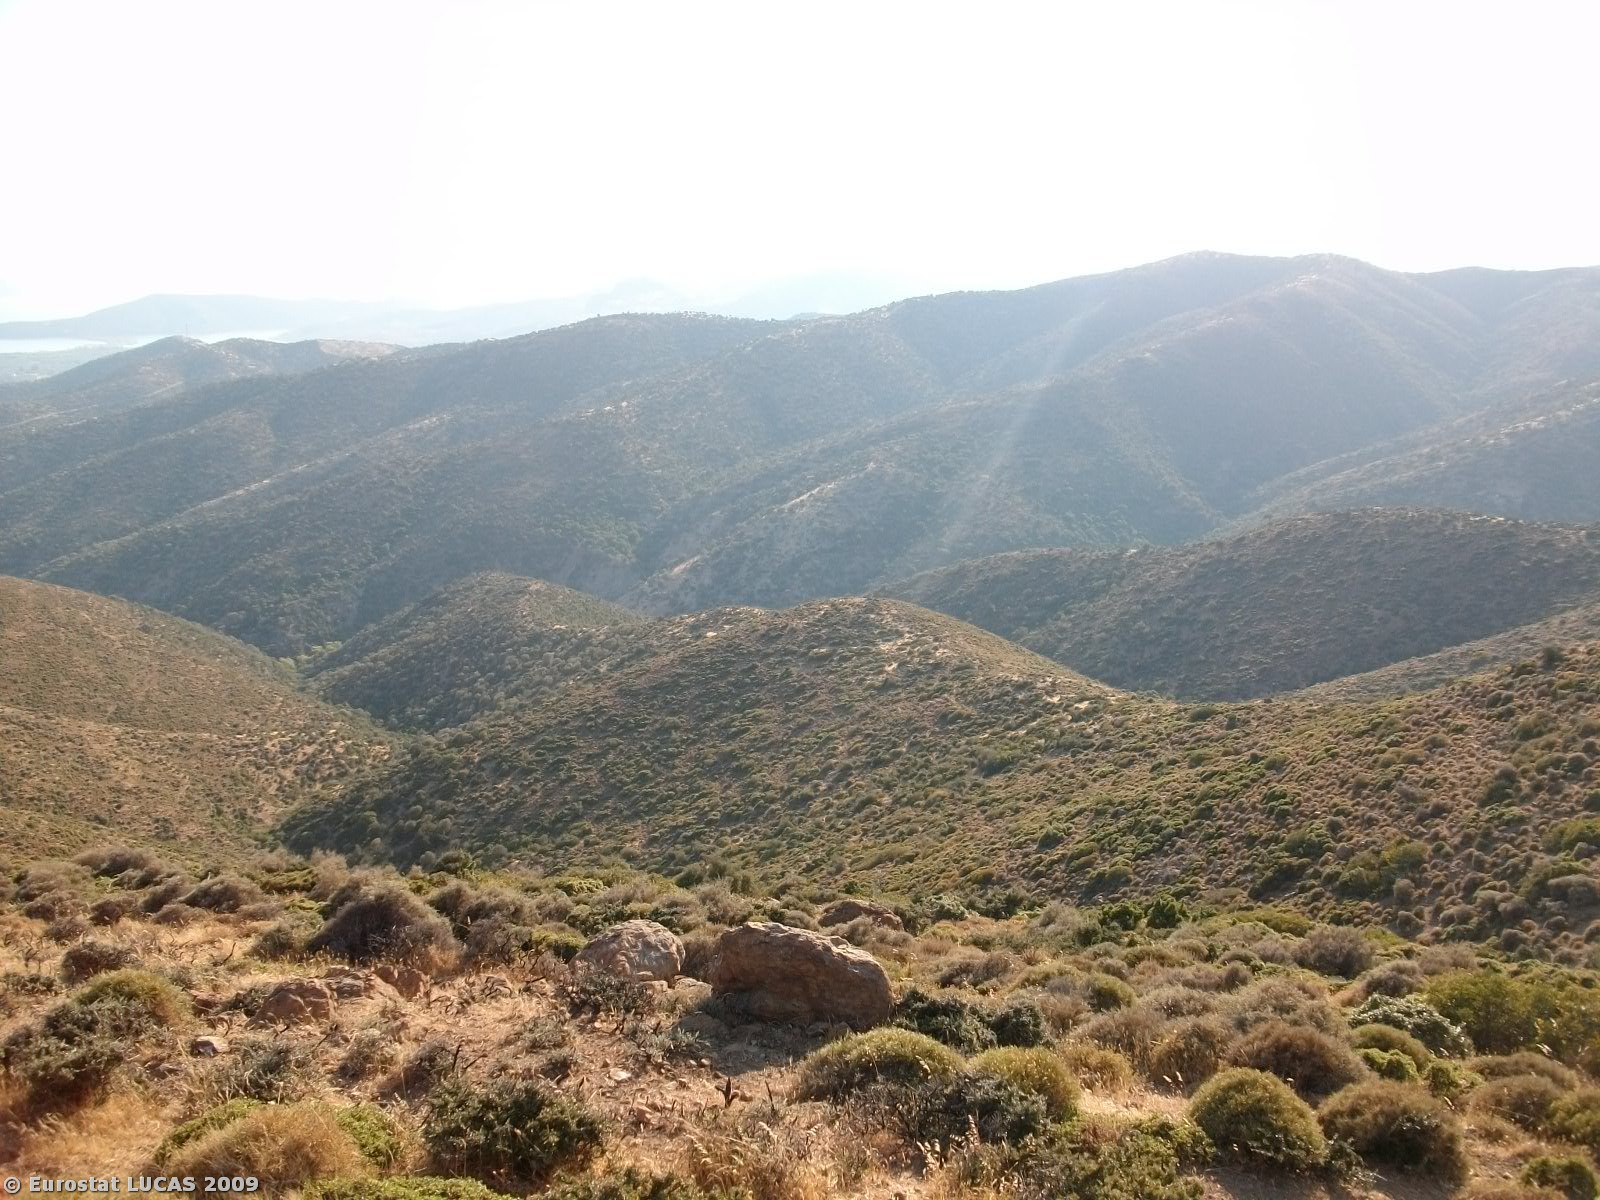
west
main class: Shrubland
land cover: Shrubland without tree cover
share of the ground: > 75 %
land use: Unused
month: August
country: GR
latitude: 37.4423
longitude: 23.3625
